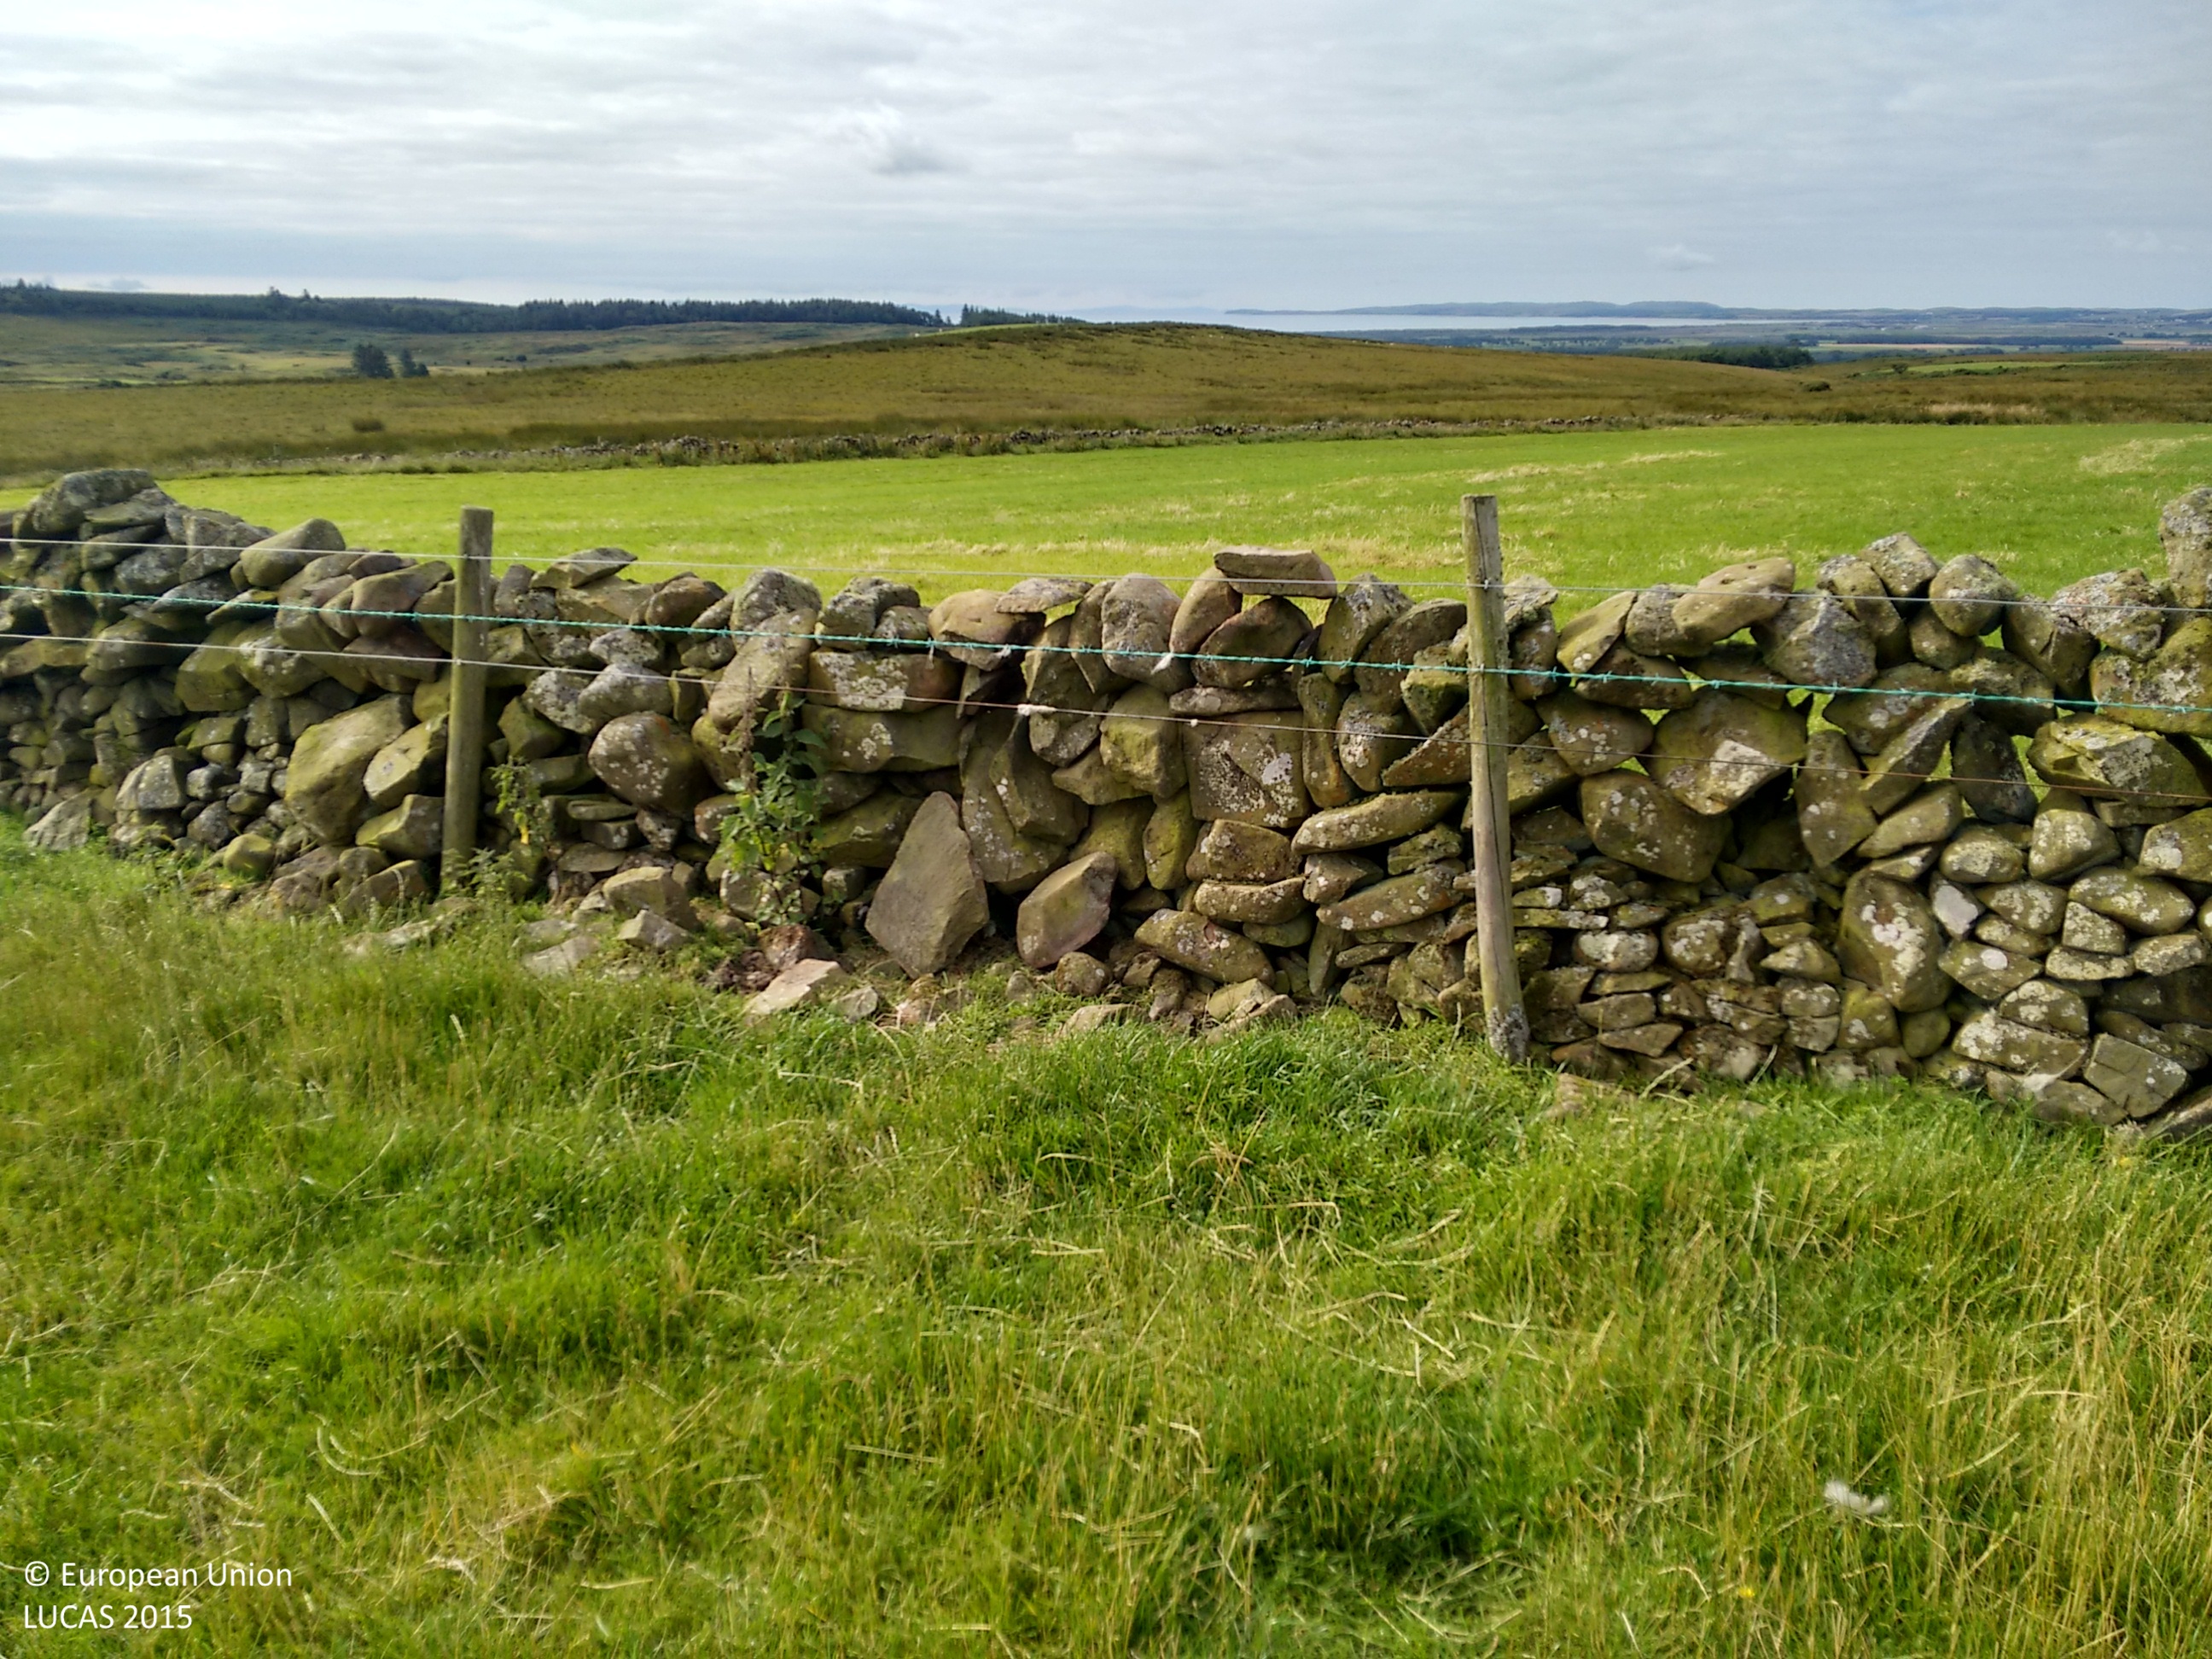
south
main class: Grassland
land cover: Grassland without tree/shrub cover
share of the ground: > 75 %
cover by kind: herbaceous plants 100 %
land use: Agriculture (excluding fallow land and kitchen gardens)
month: August
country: GB
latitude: 54.9237
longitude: -4.9193
